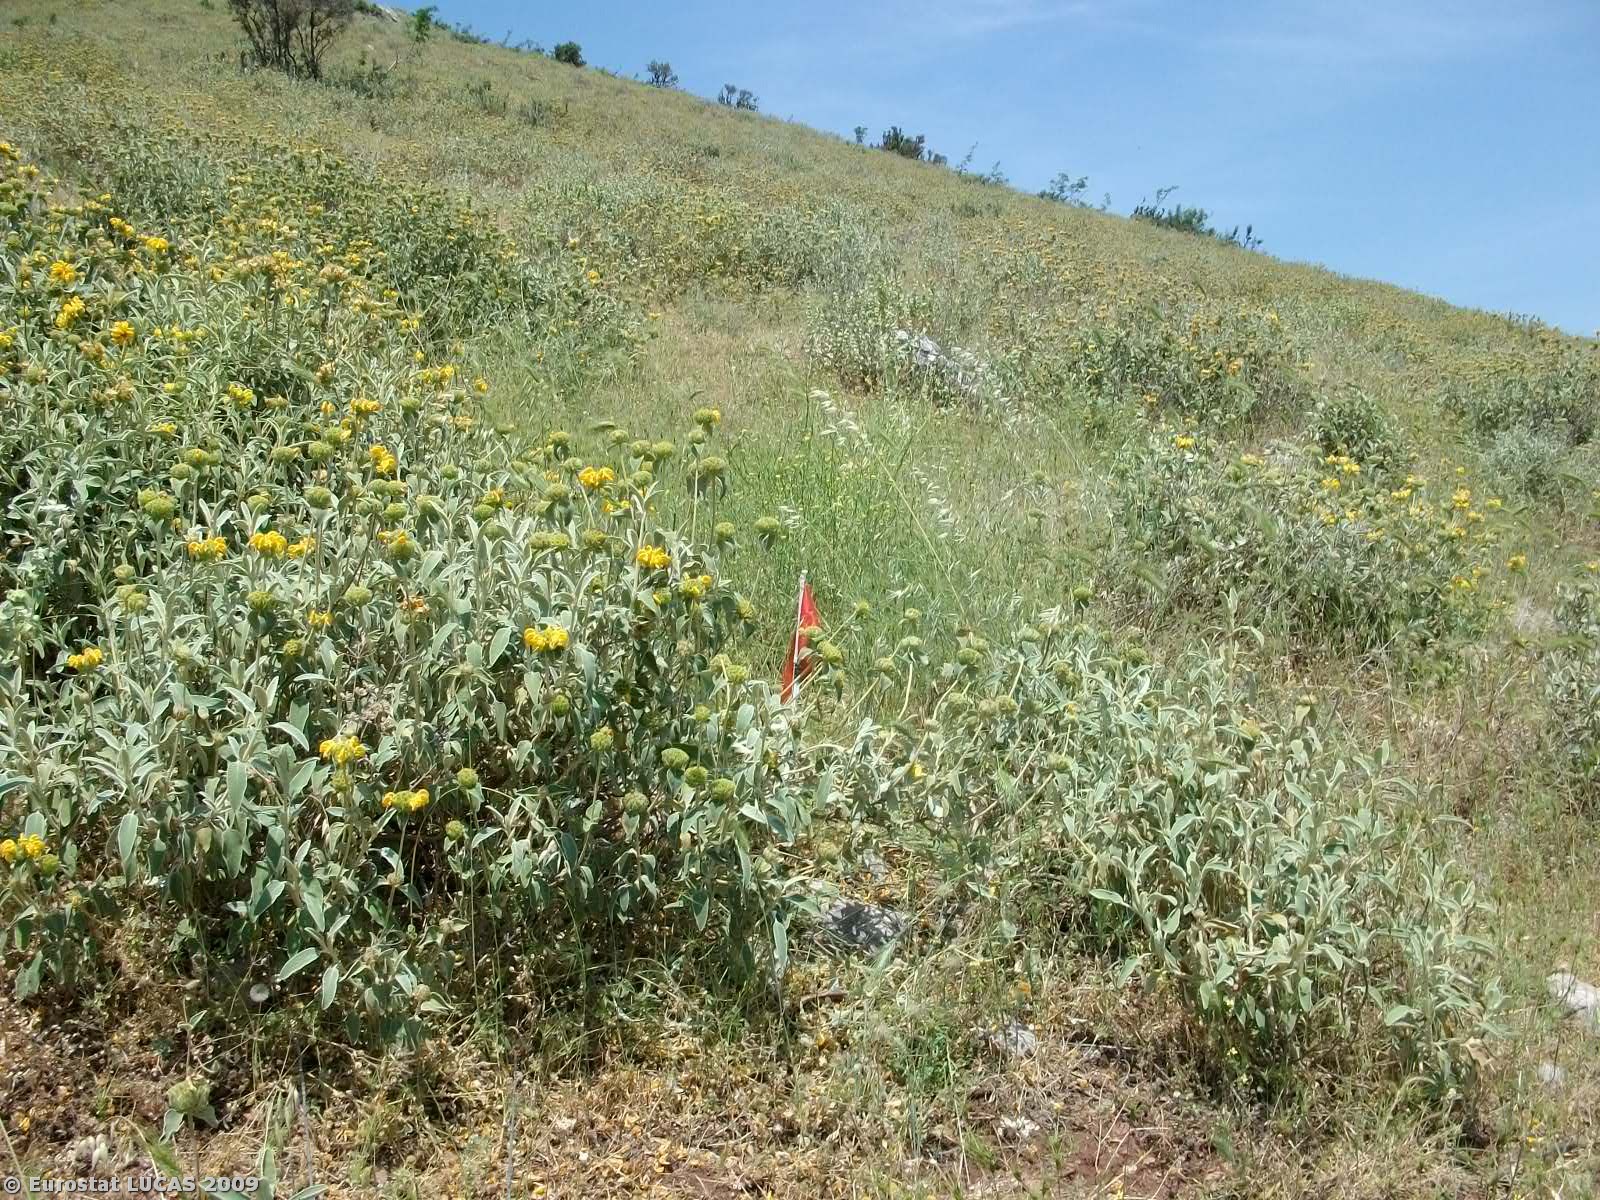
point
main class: Grassland
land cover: Grassland without tree/shrub cover
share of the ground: > 75 %
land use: Agriculture (excluding fallow land and kitchen gardens)
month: May
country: GR
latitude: 39.2850
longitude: 22.3316
